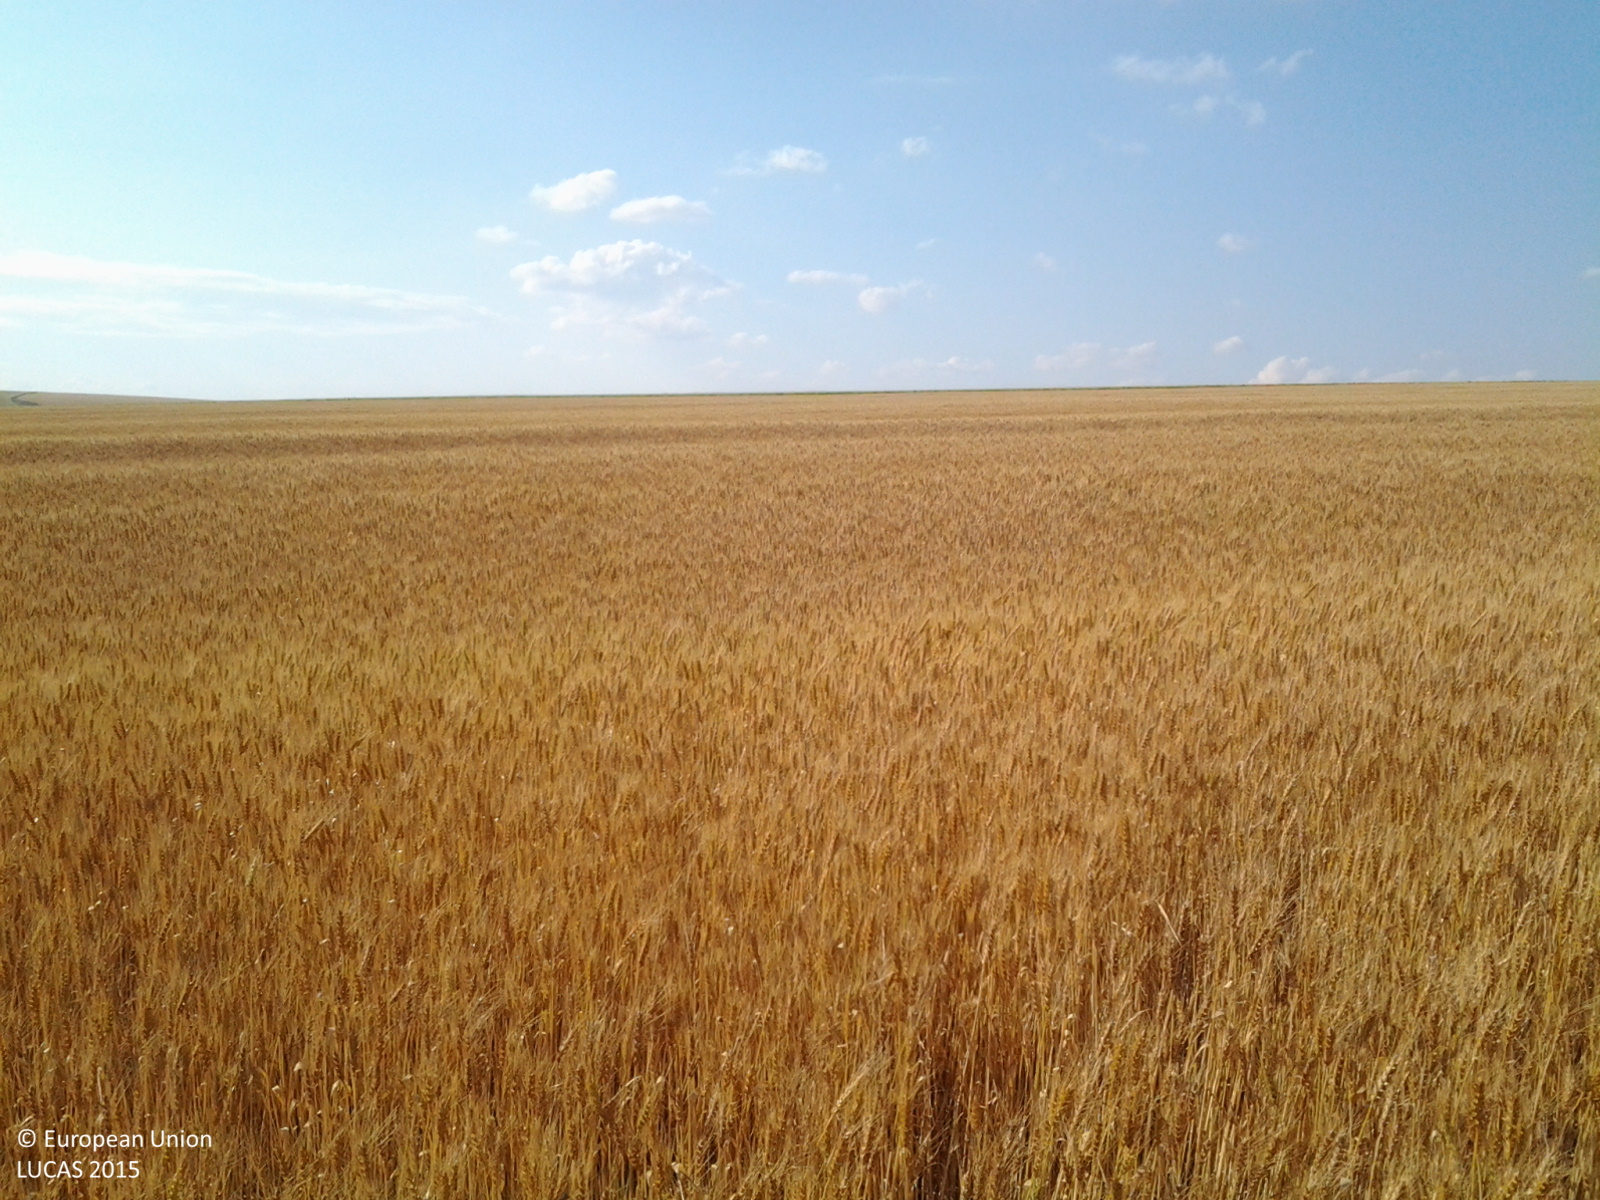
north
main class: Cropland
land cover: Common wheat
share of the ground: > 75 %
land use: Agriculture (excluding fallow land and kitchen gardens)
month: June
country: RO
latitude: 47.5665
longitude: 27.0250
